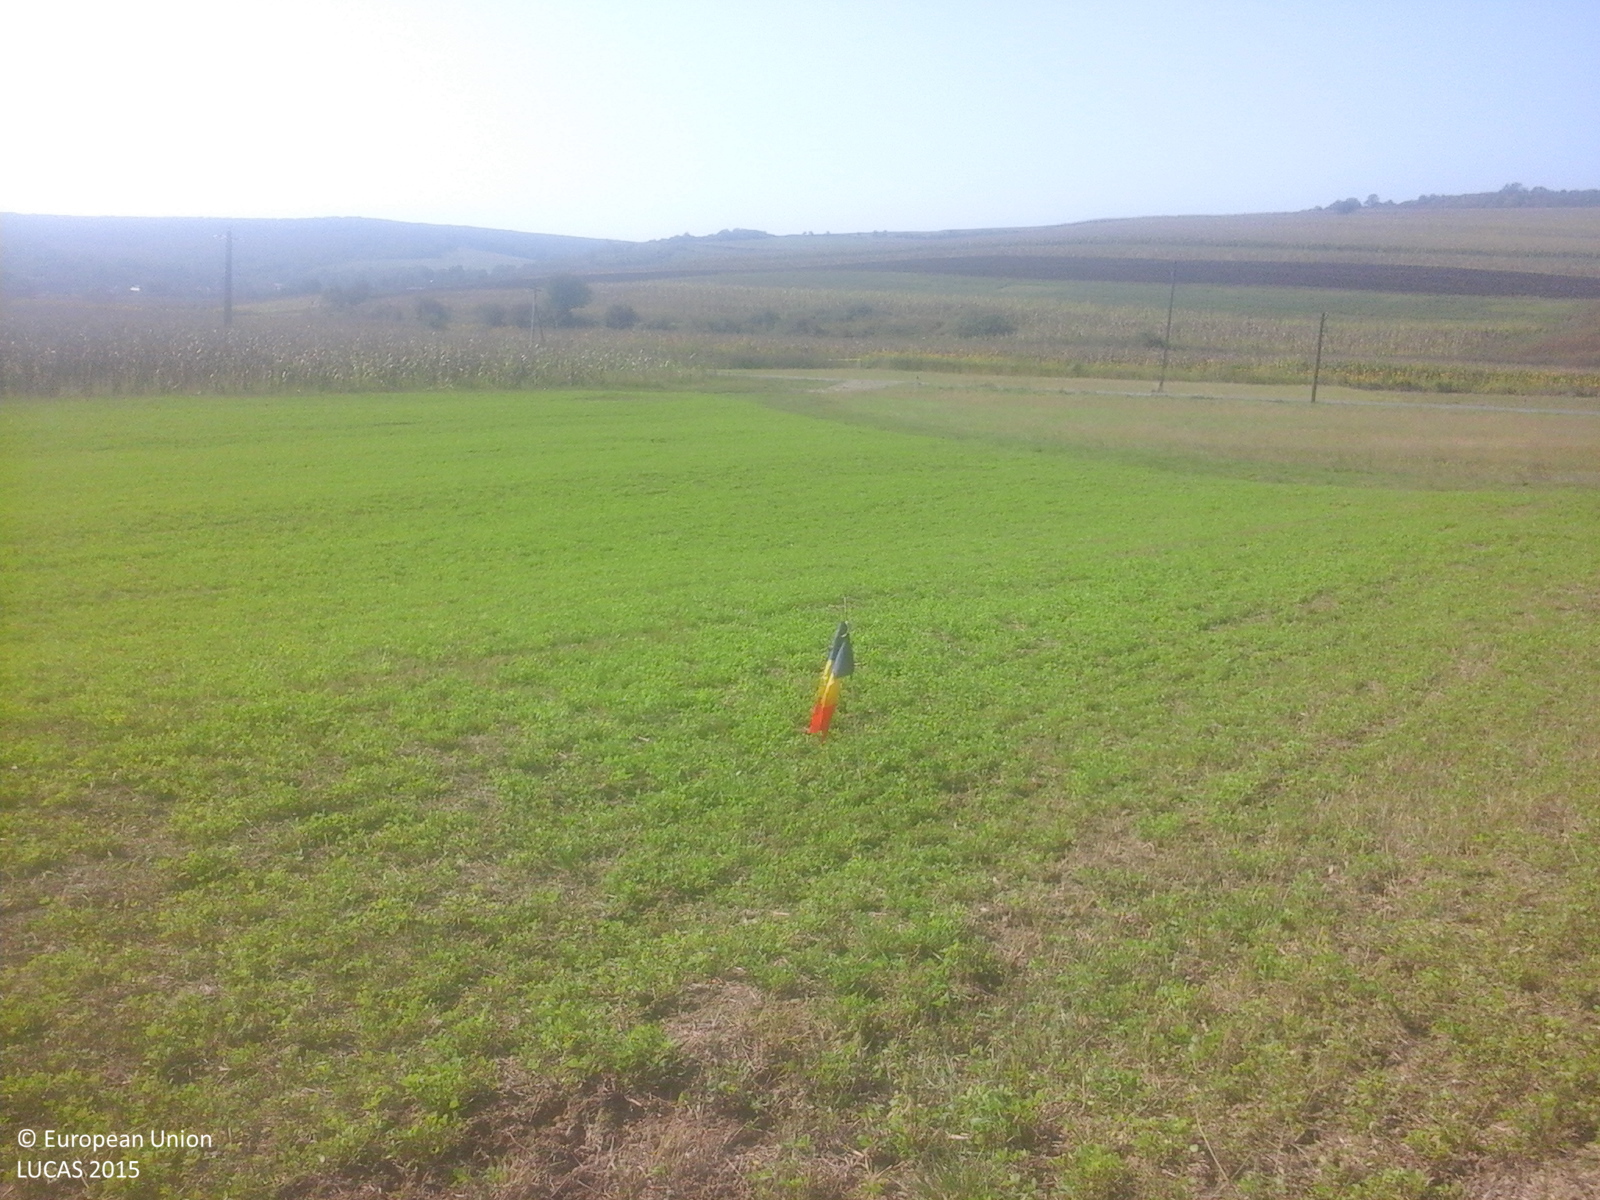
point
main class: Cropland
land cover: Clovers
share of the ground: > 75 %
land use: Agriculture (excluding fallow land and kitchen gardens)
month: October
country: RO
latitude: 45.9866
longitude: 23.8974
